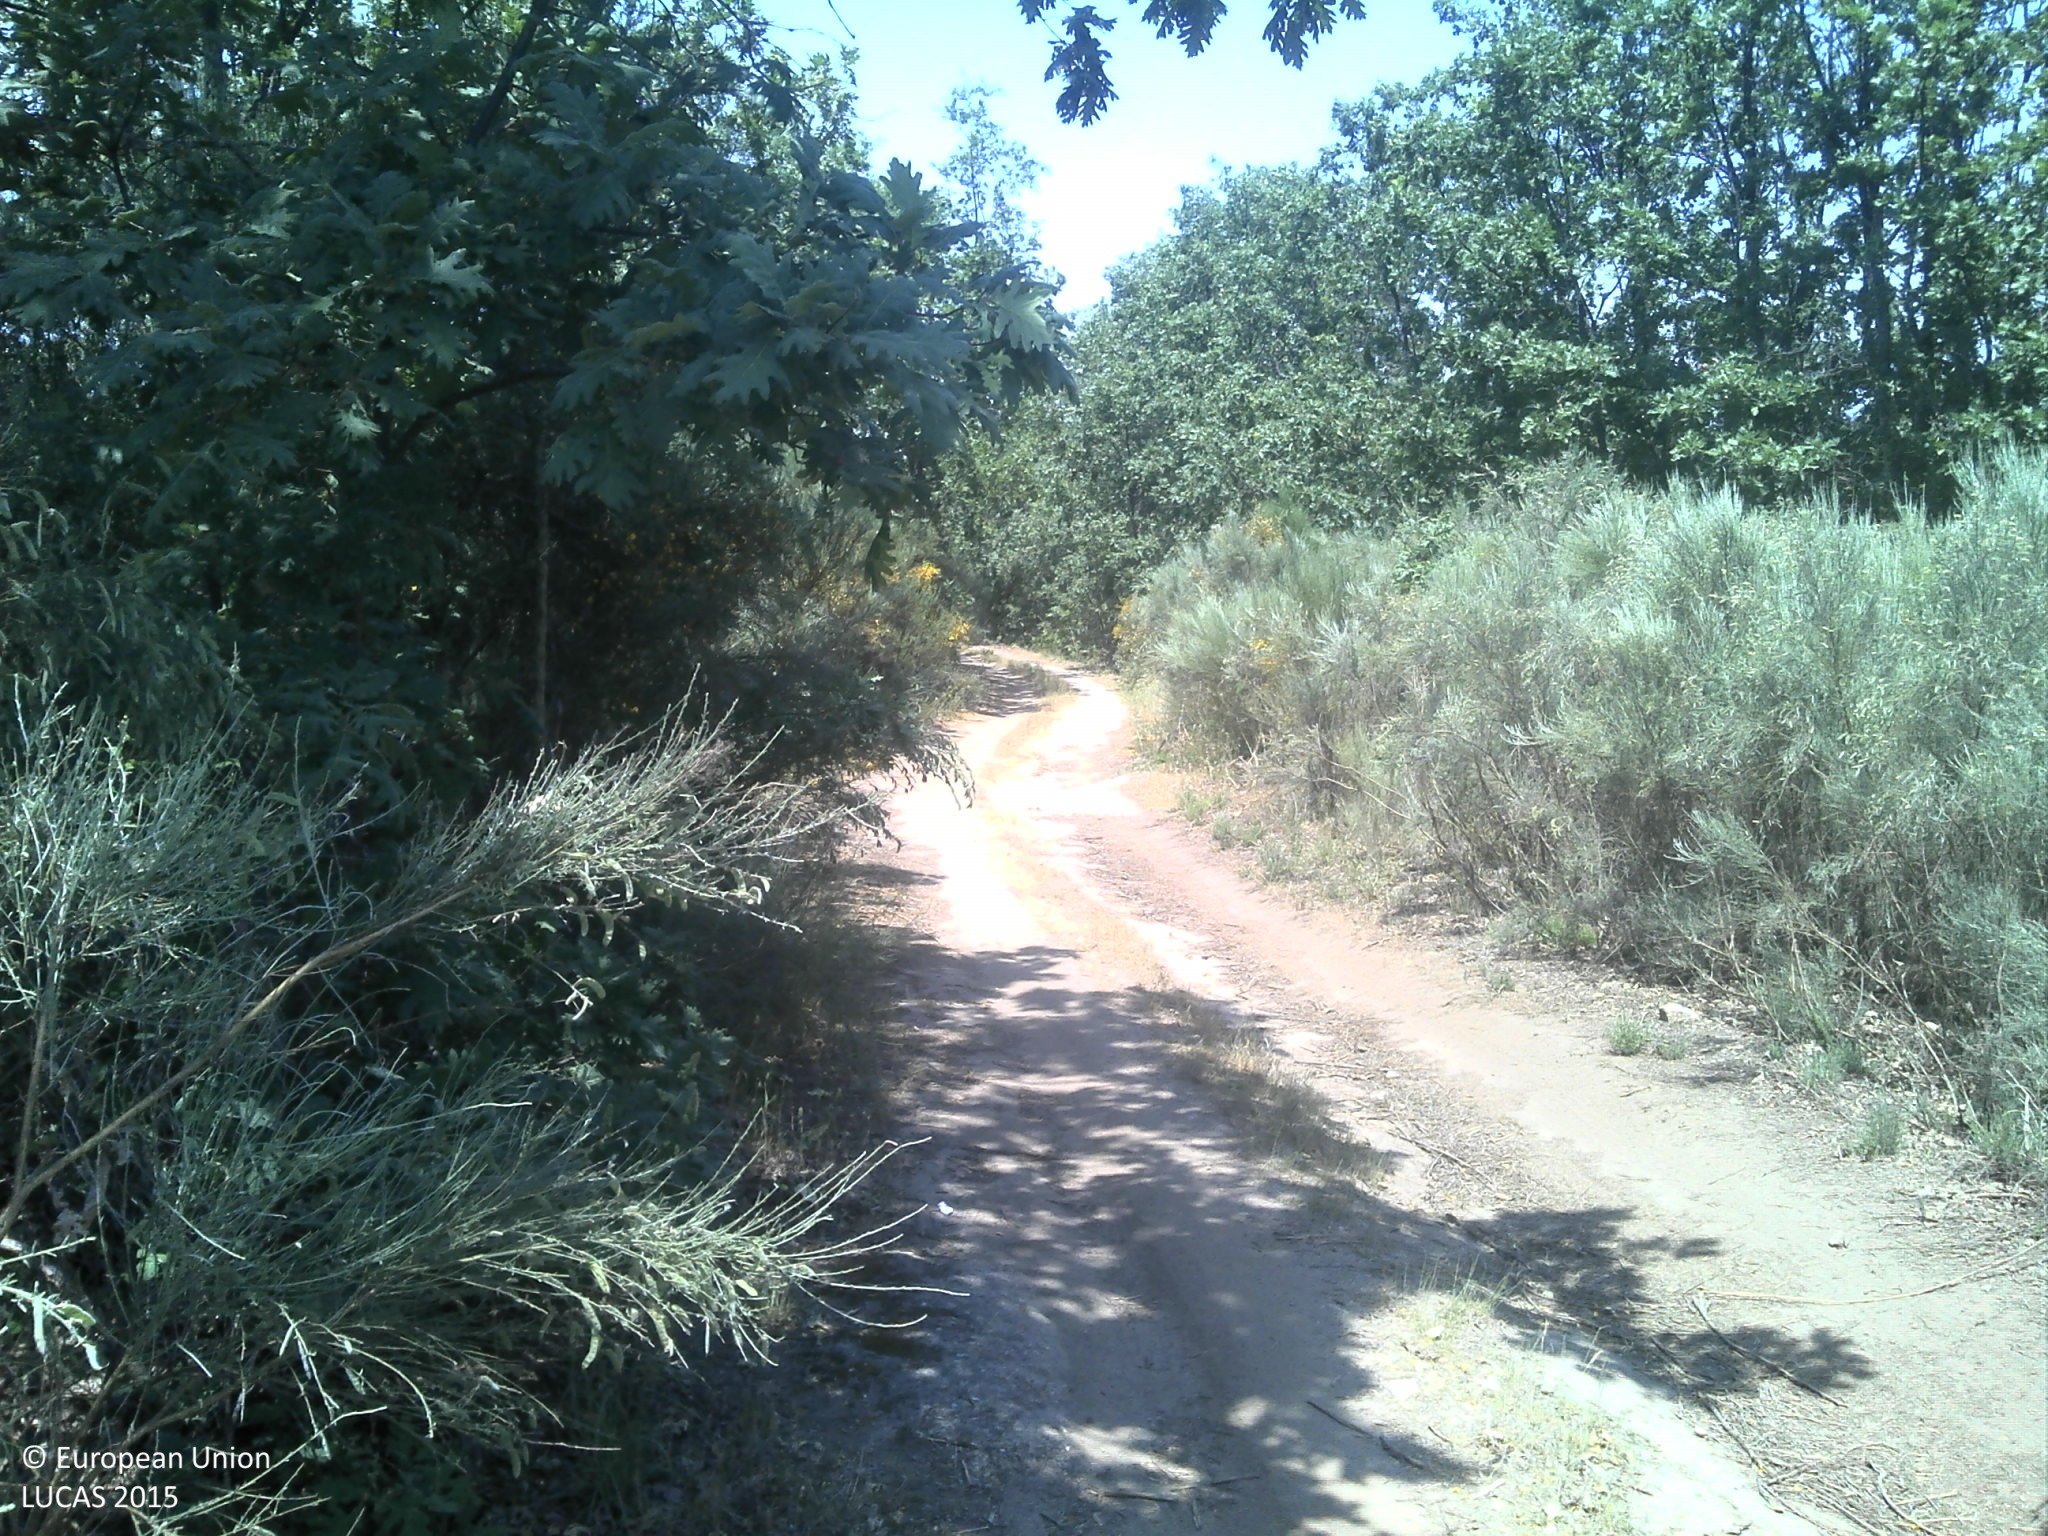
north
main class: Shrubland
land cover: Shrubland with sparse tree cover
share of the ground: 50 - 75 %
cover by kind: shrubs 70 %, unconsolidated bare surface 10 %, broadleaved forest trees 5 %, herbaceous plants 5 %
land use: Forestry
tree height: > 5 m
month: June
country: PT
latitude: 40.3646
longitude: -6.8506
